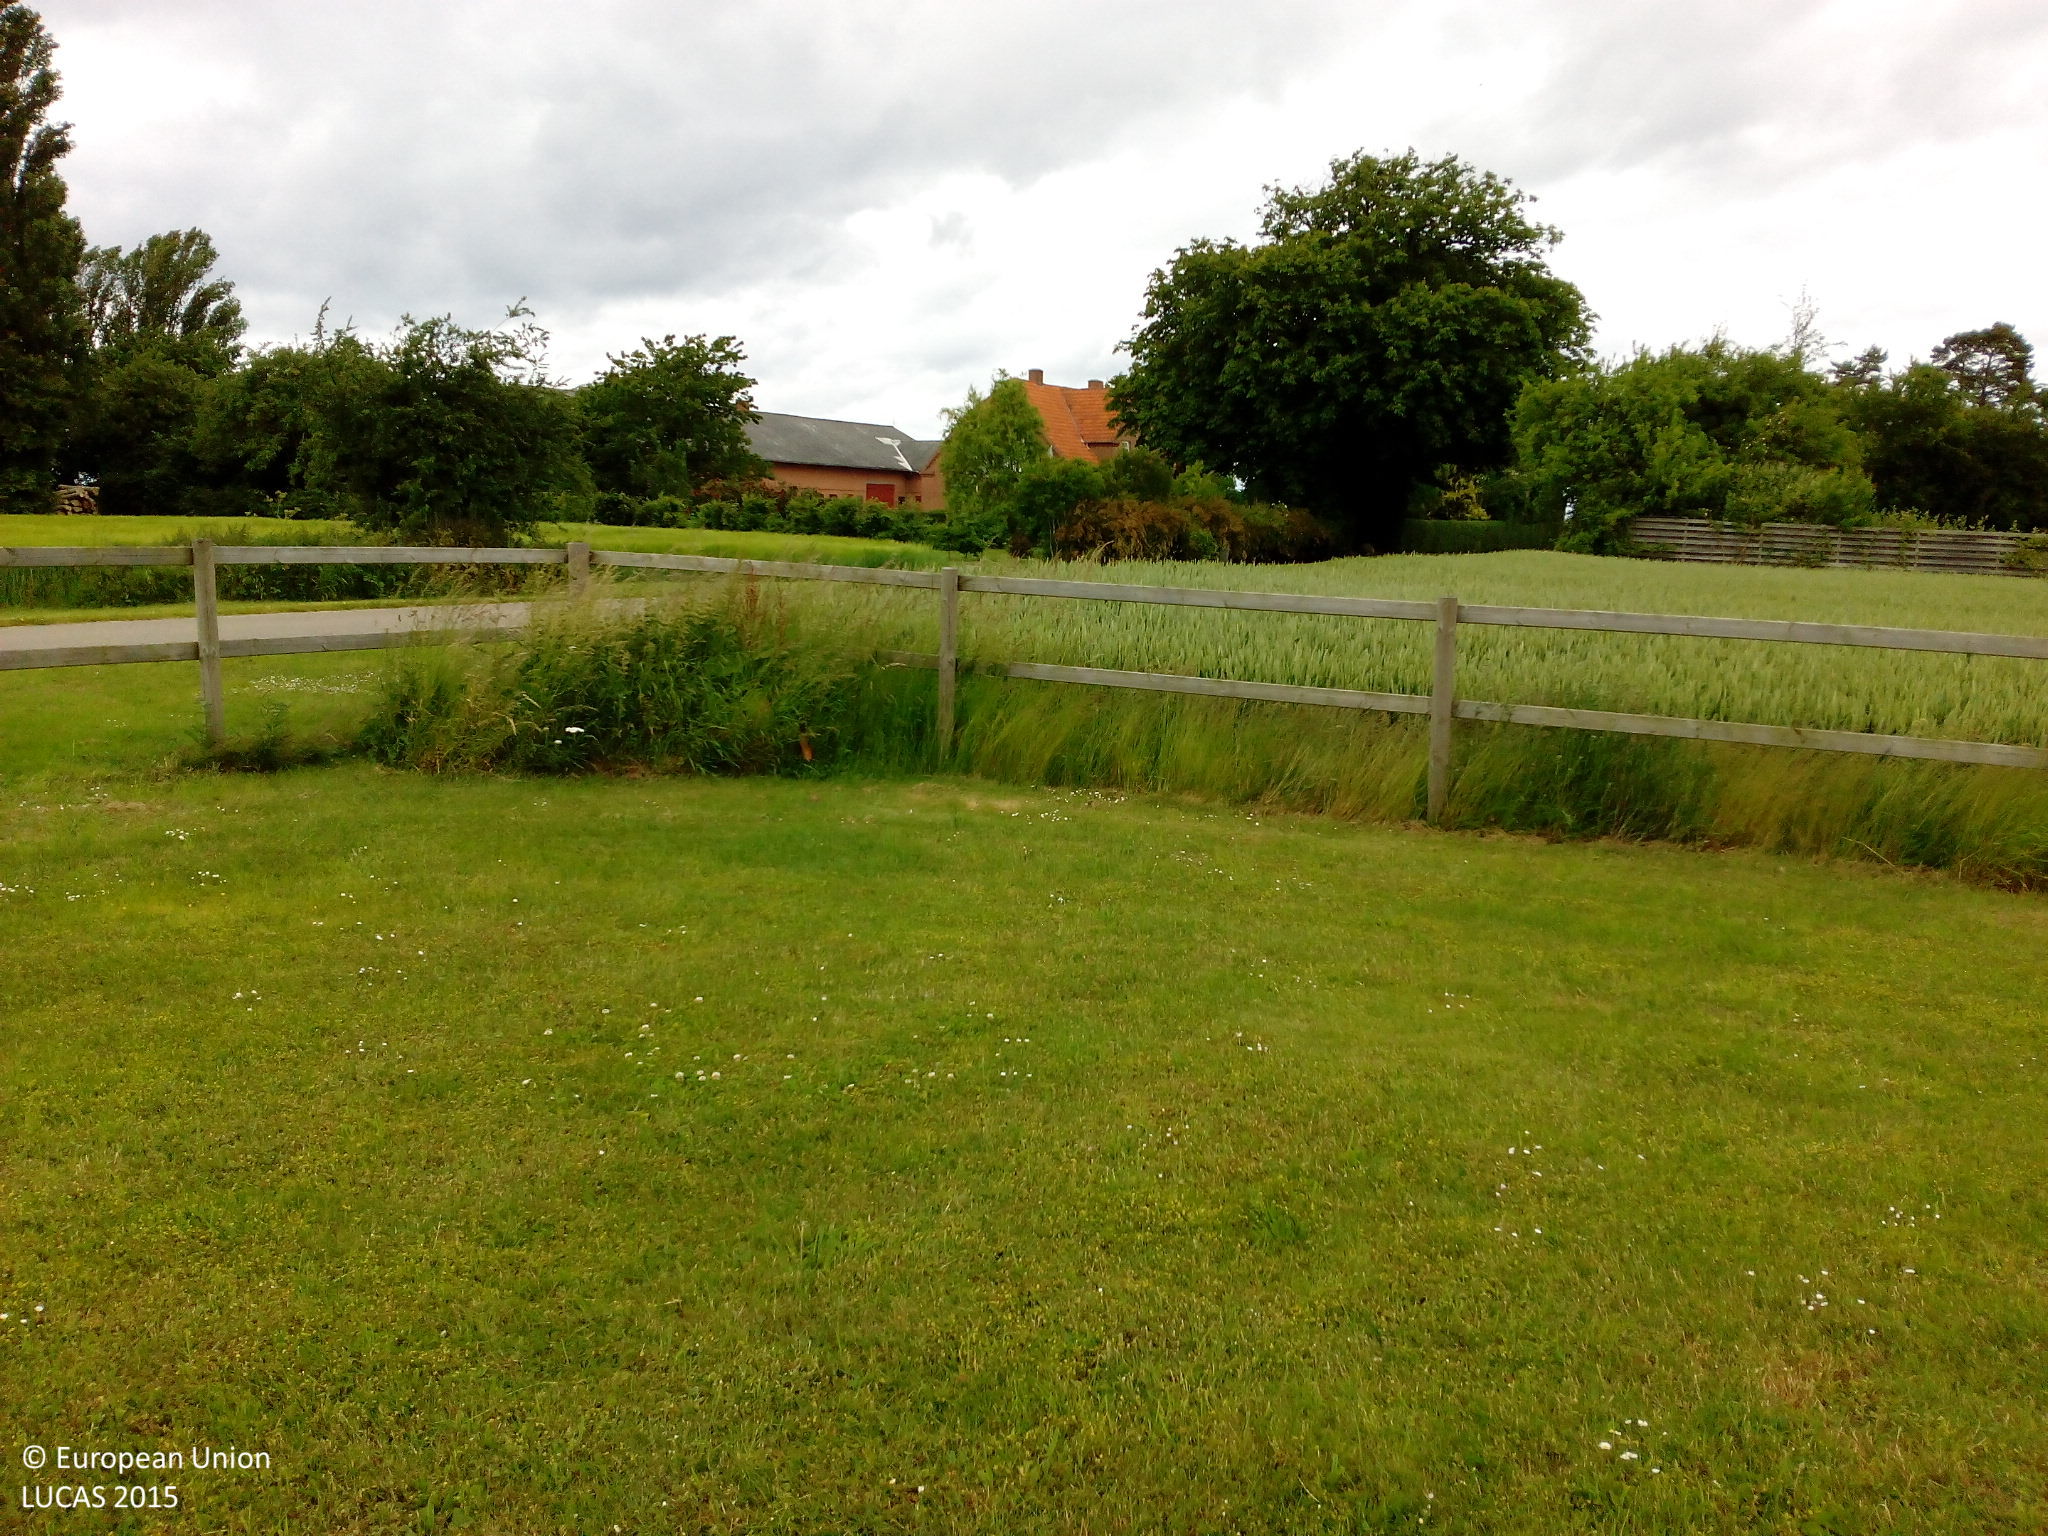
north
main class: Grassland
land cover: Grassland without tree/shrub cover
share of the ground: > 75 %
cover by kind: herbaceous plants 100 %
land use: Agriculture (excluding fallow land and kitchen gardens)
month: June
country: DK
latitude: 54.8470
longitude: 11.6341
